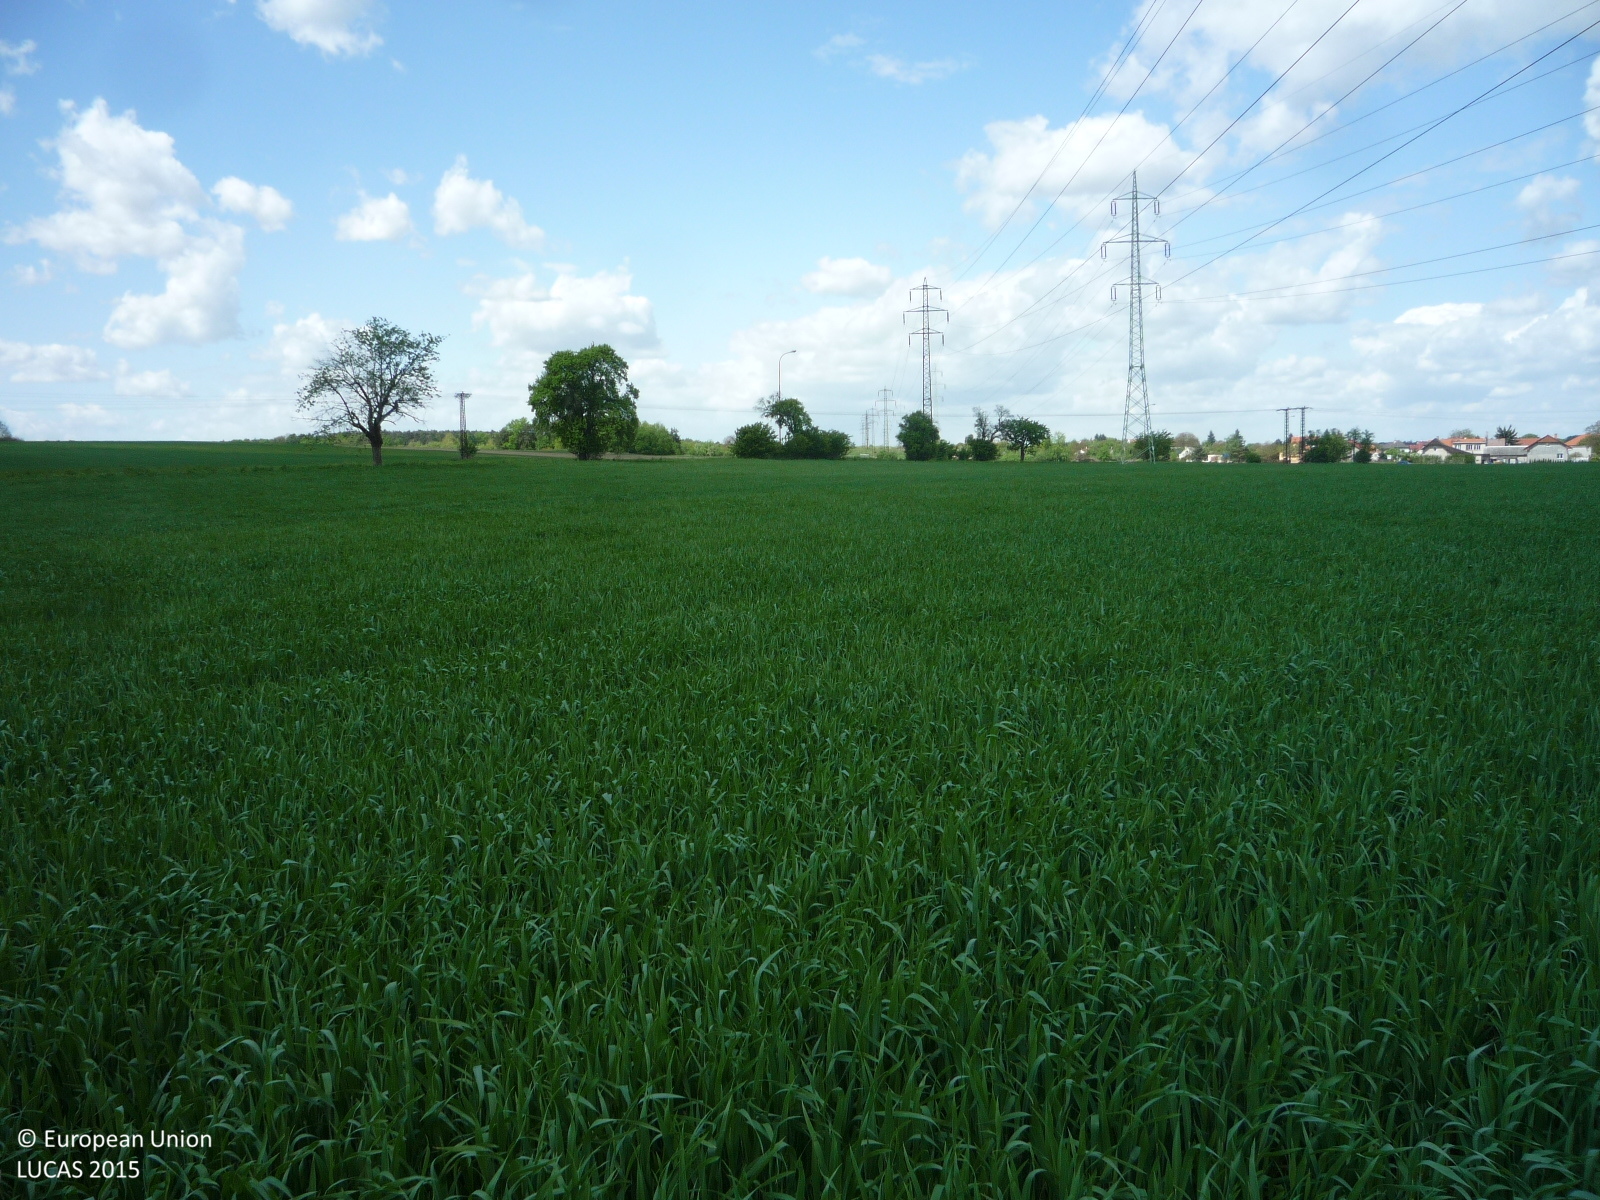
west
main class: Cropland
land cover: Barley
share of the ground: > 75 %
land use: Agriculture (excluding fallow land and kitchen gardens)
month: May
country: CZ
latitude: 50.1145
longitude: 14.9111
